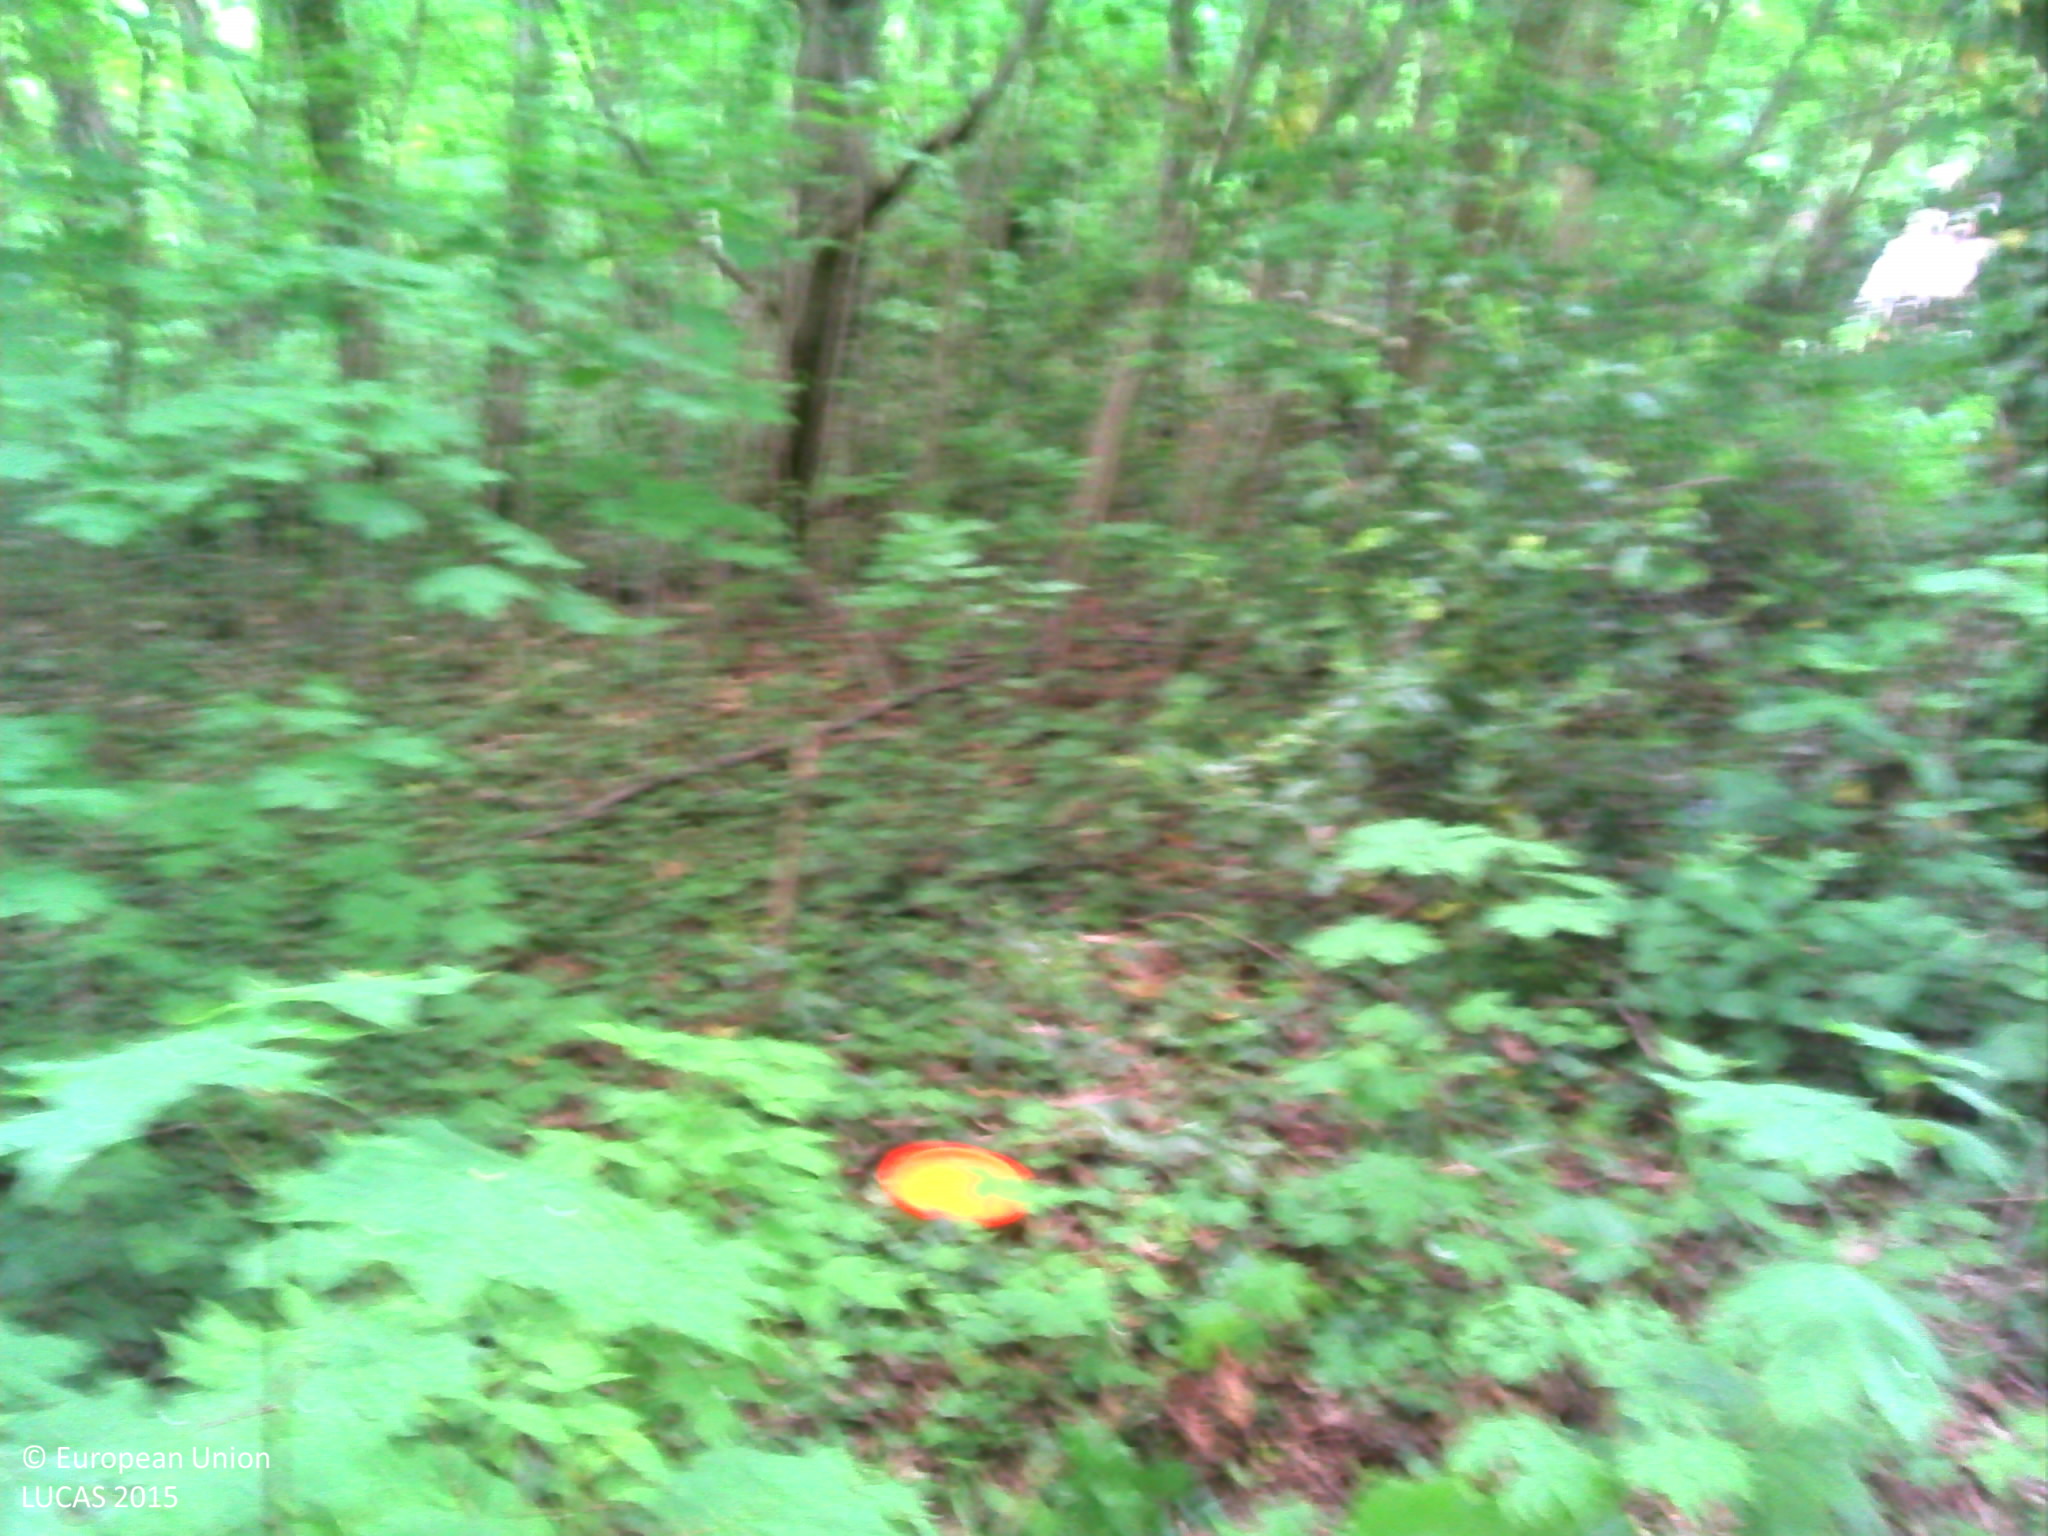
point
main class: Woodland
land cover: Broadleaved woodland
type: beech forest
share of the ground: > 75 %
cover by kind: broadleaved forest trees 100 %
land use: Forestry
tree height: > 5 m
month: May
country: BE
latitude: 50.6819
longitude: 4.4903
